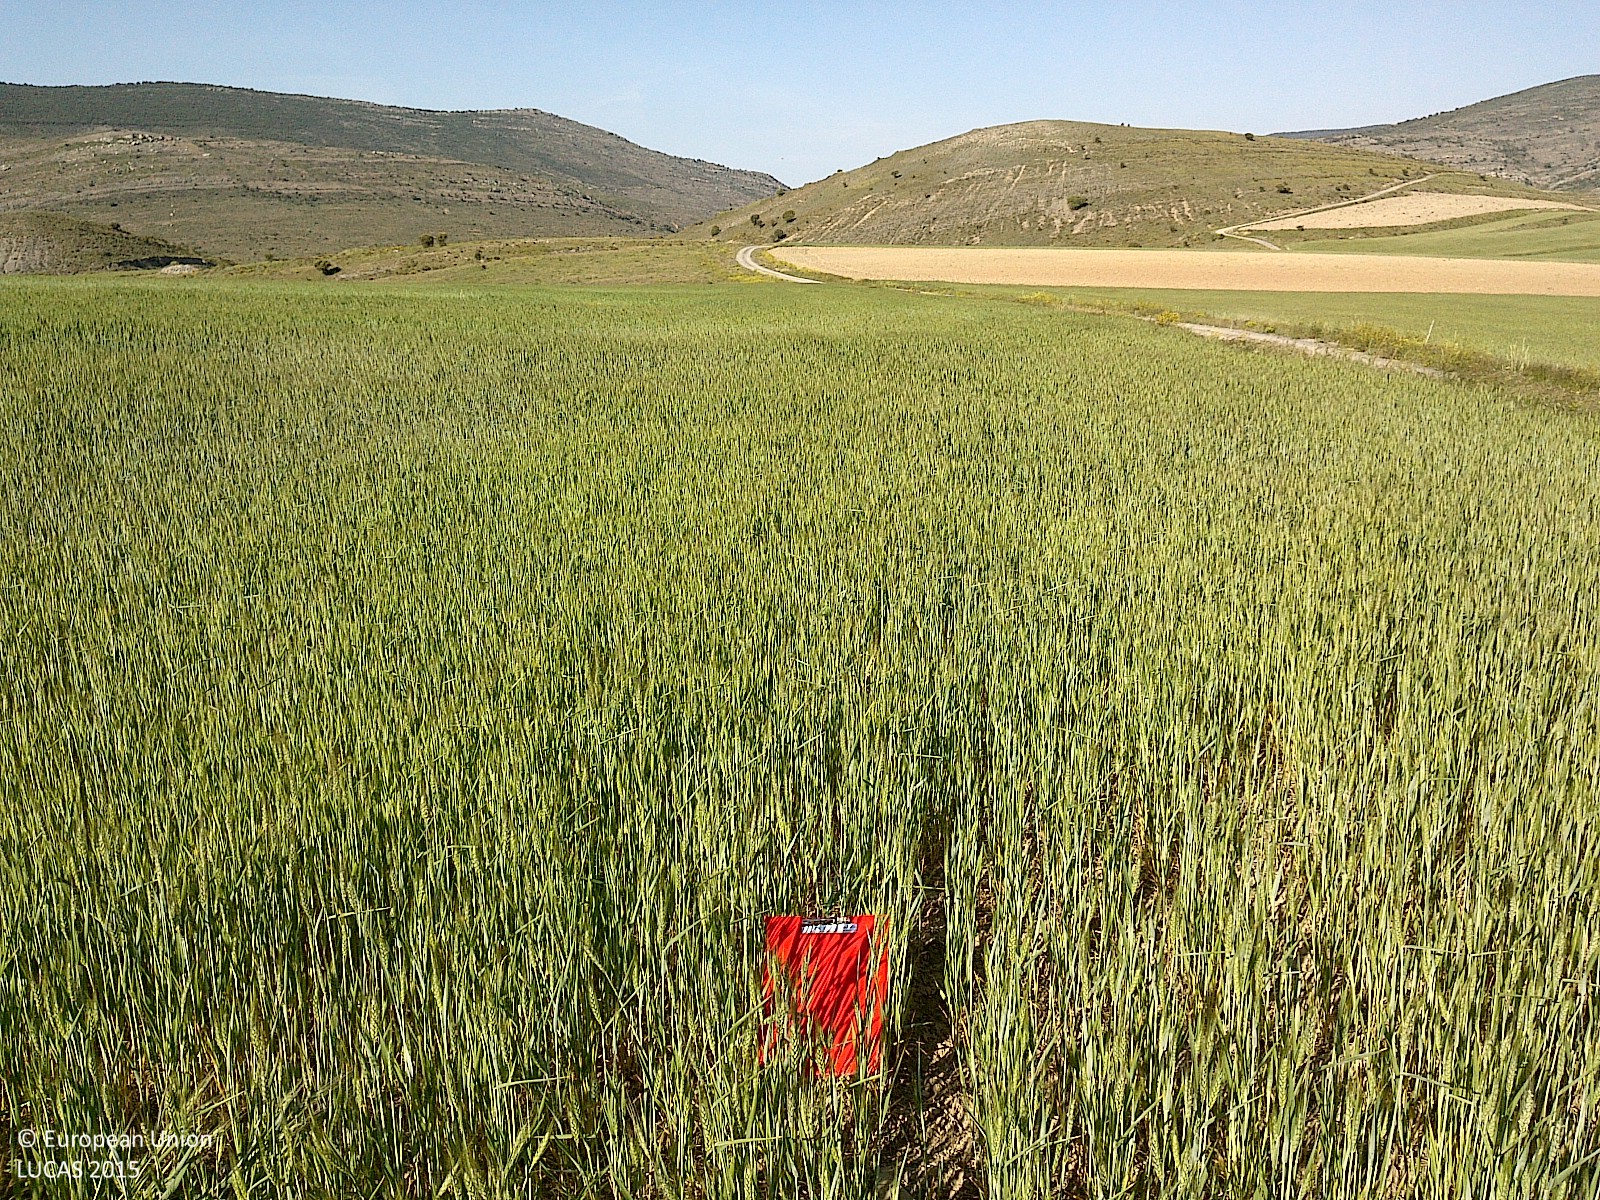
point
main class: Cropland
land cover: Barley
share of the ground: > 75 %
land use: Agriculture (excluding fallow land and kitchen gardens)
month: May
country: ES
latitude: 42.0945
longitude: -2.3605
